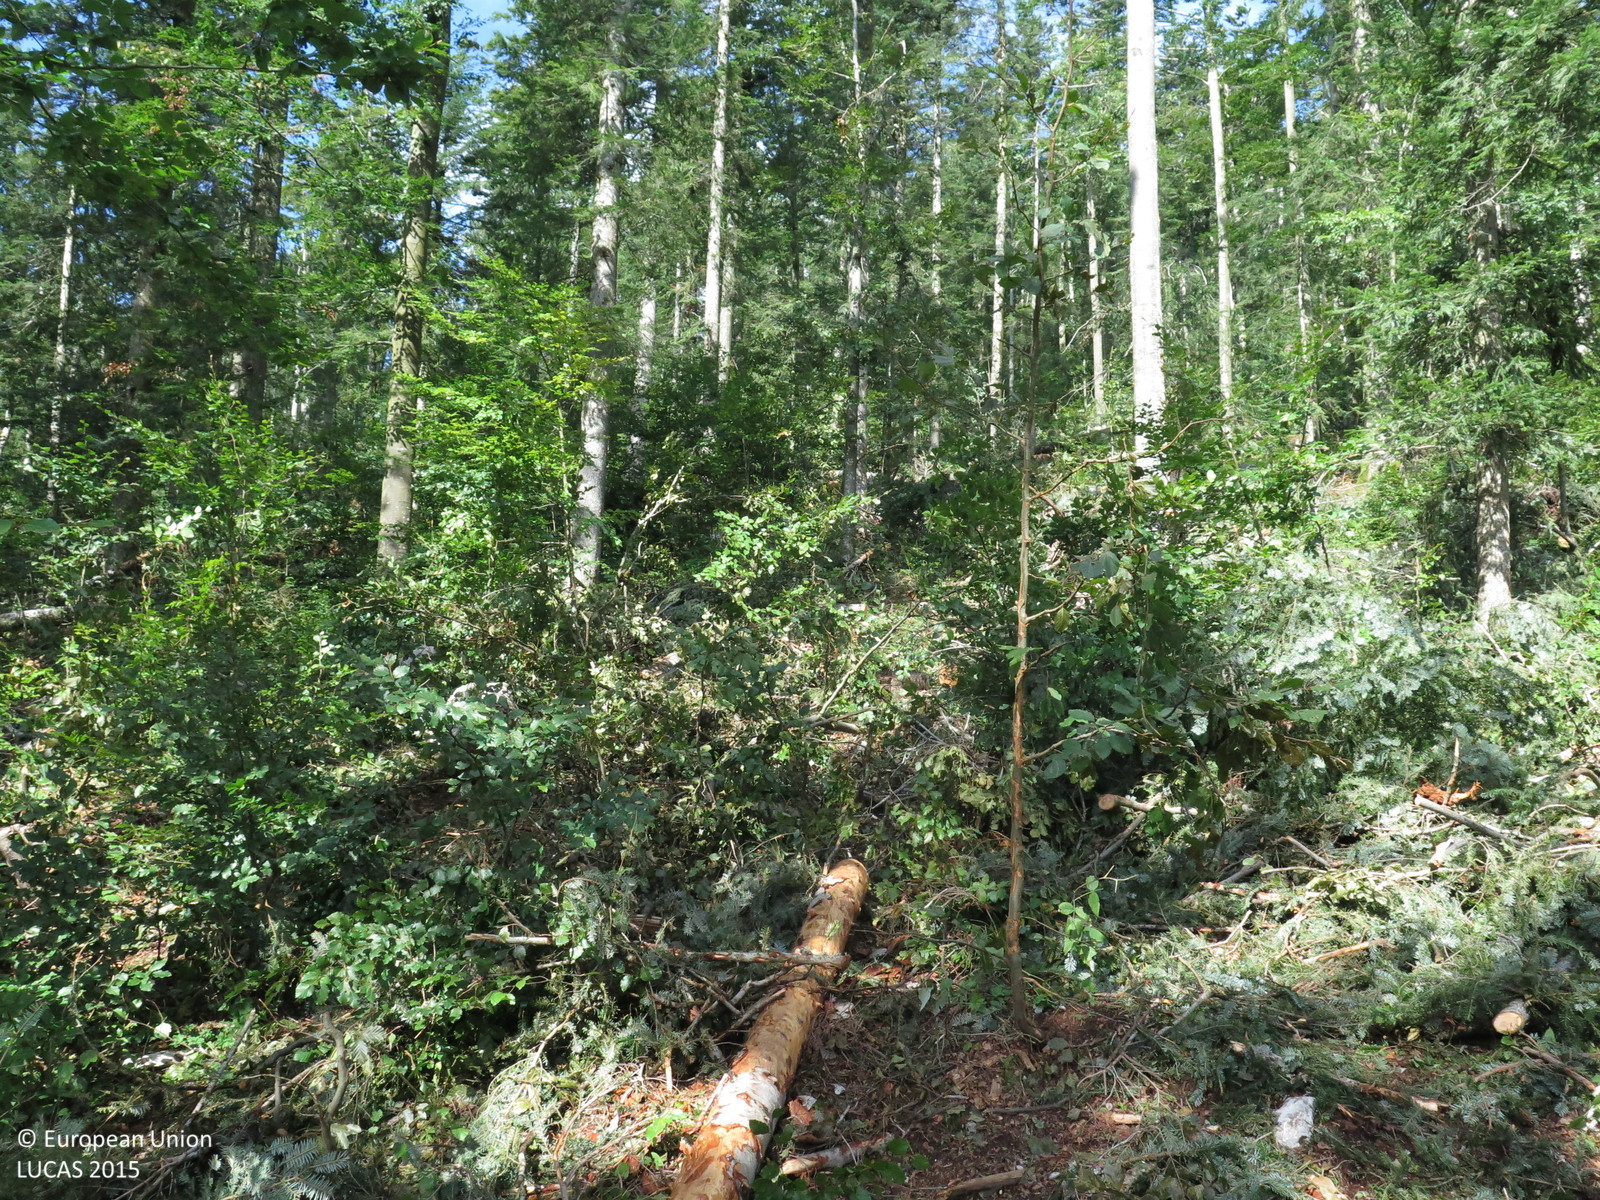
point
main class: Woodland
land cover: Other mixed woodland
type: mountainous beech forest
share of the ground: > 75 %
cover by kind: broadleaved forest trees 75 %, coniferous forest trees 25 %
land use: Forestry
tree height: > 5 m
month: September
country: HR
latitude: 45.4758
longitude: 14.6133
